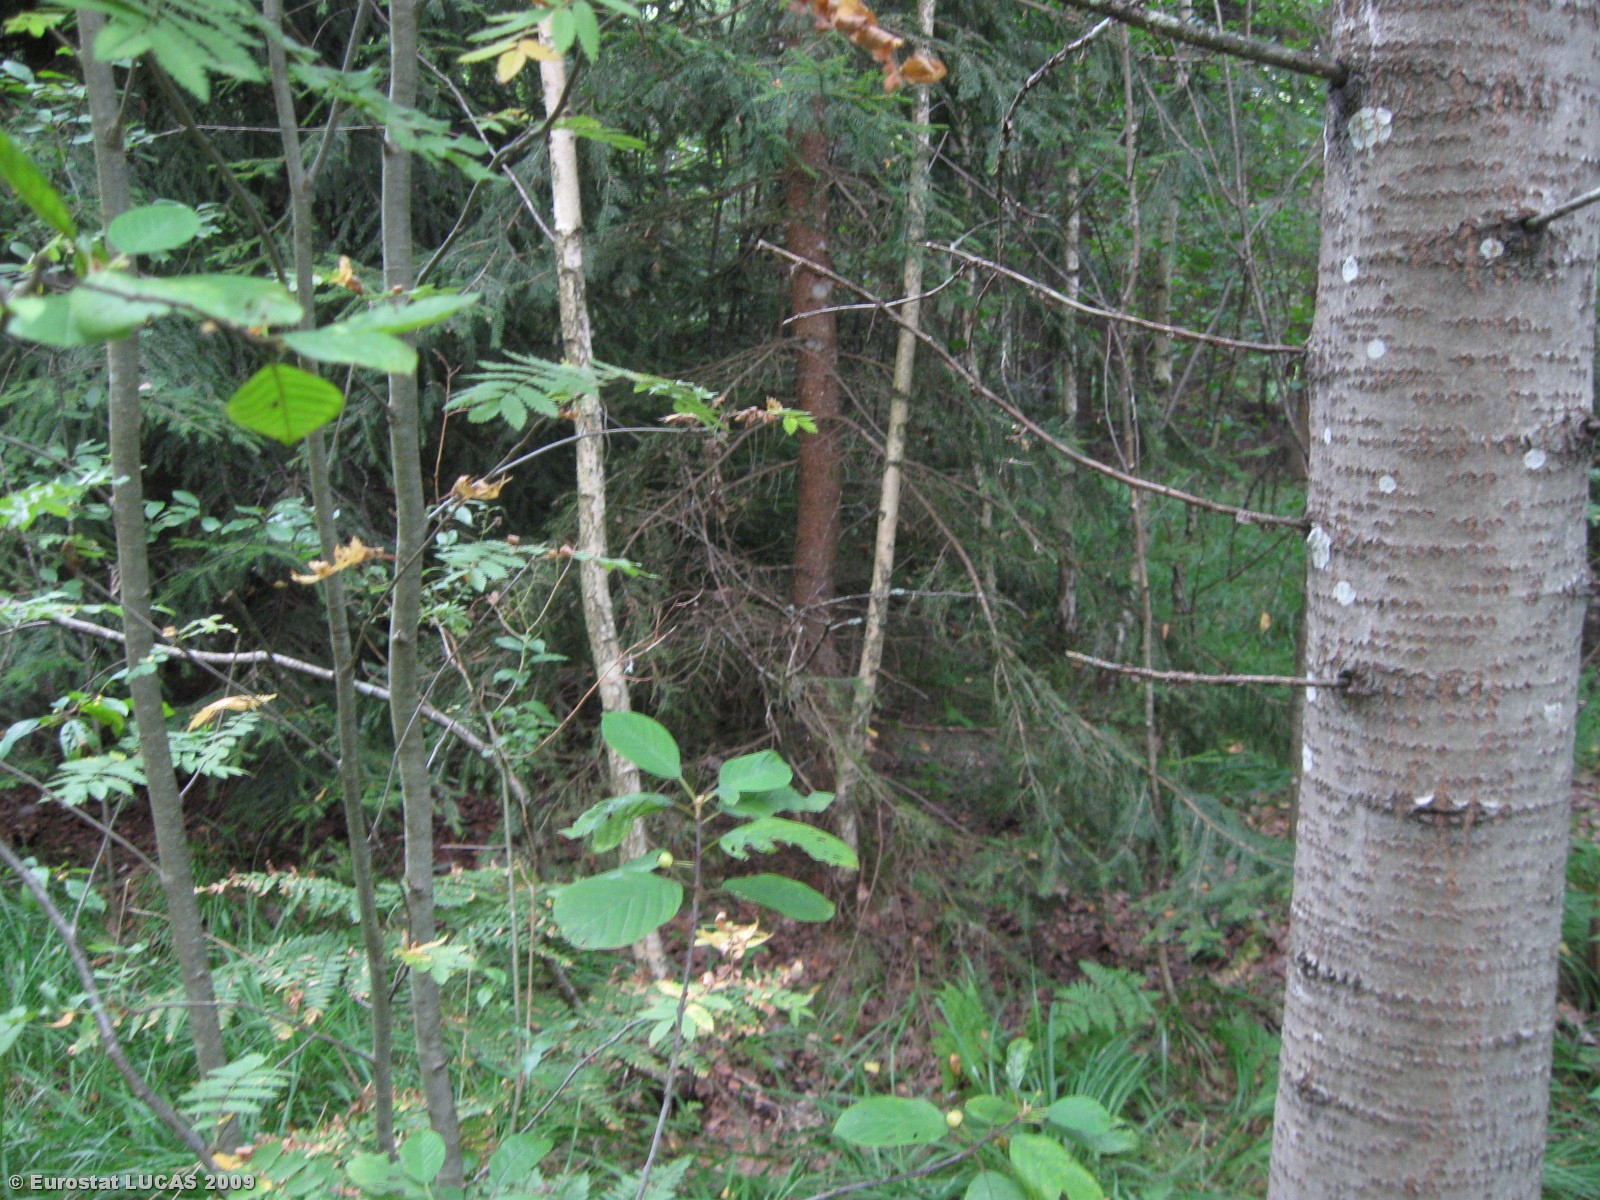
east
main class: Woodland
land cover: Mixed woodland
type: hemiboreal forest and nemoral coniferous forest and mixed broadleaved-coniferous forest
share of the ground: > 75 %
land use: Forestry
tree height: > 5 m
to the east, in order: Mixed woodland; Ditches and canals; Groves; Grassland without tree/shrub cover; Shruby margins; Grassland without tree/shrub cover; Abandoned hedges; Ditches and canals; Abandoned hedges; Paved roads, cycling and walking lanes; Grass margins; Lines of trees; Grassland without tree/shrub cover; Paved roads, cycling and walking lanes; Grassland without tree/shrub cover; Fences; Grassland without tree/shrub cover; Artificial constructions in urban areas
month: August
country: LT
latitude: 55.0915
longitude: 22.5830
